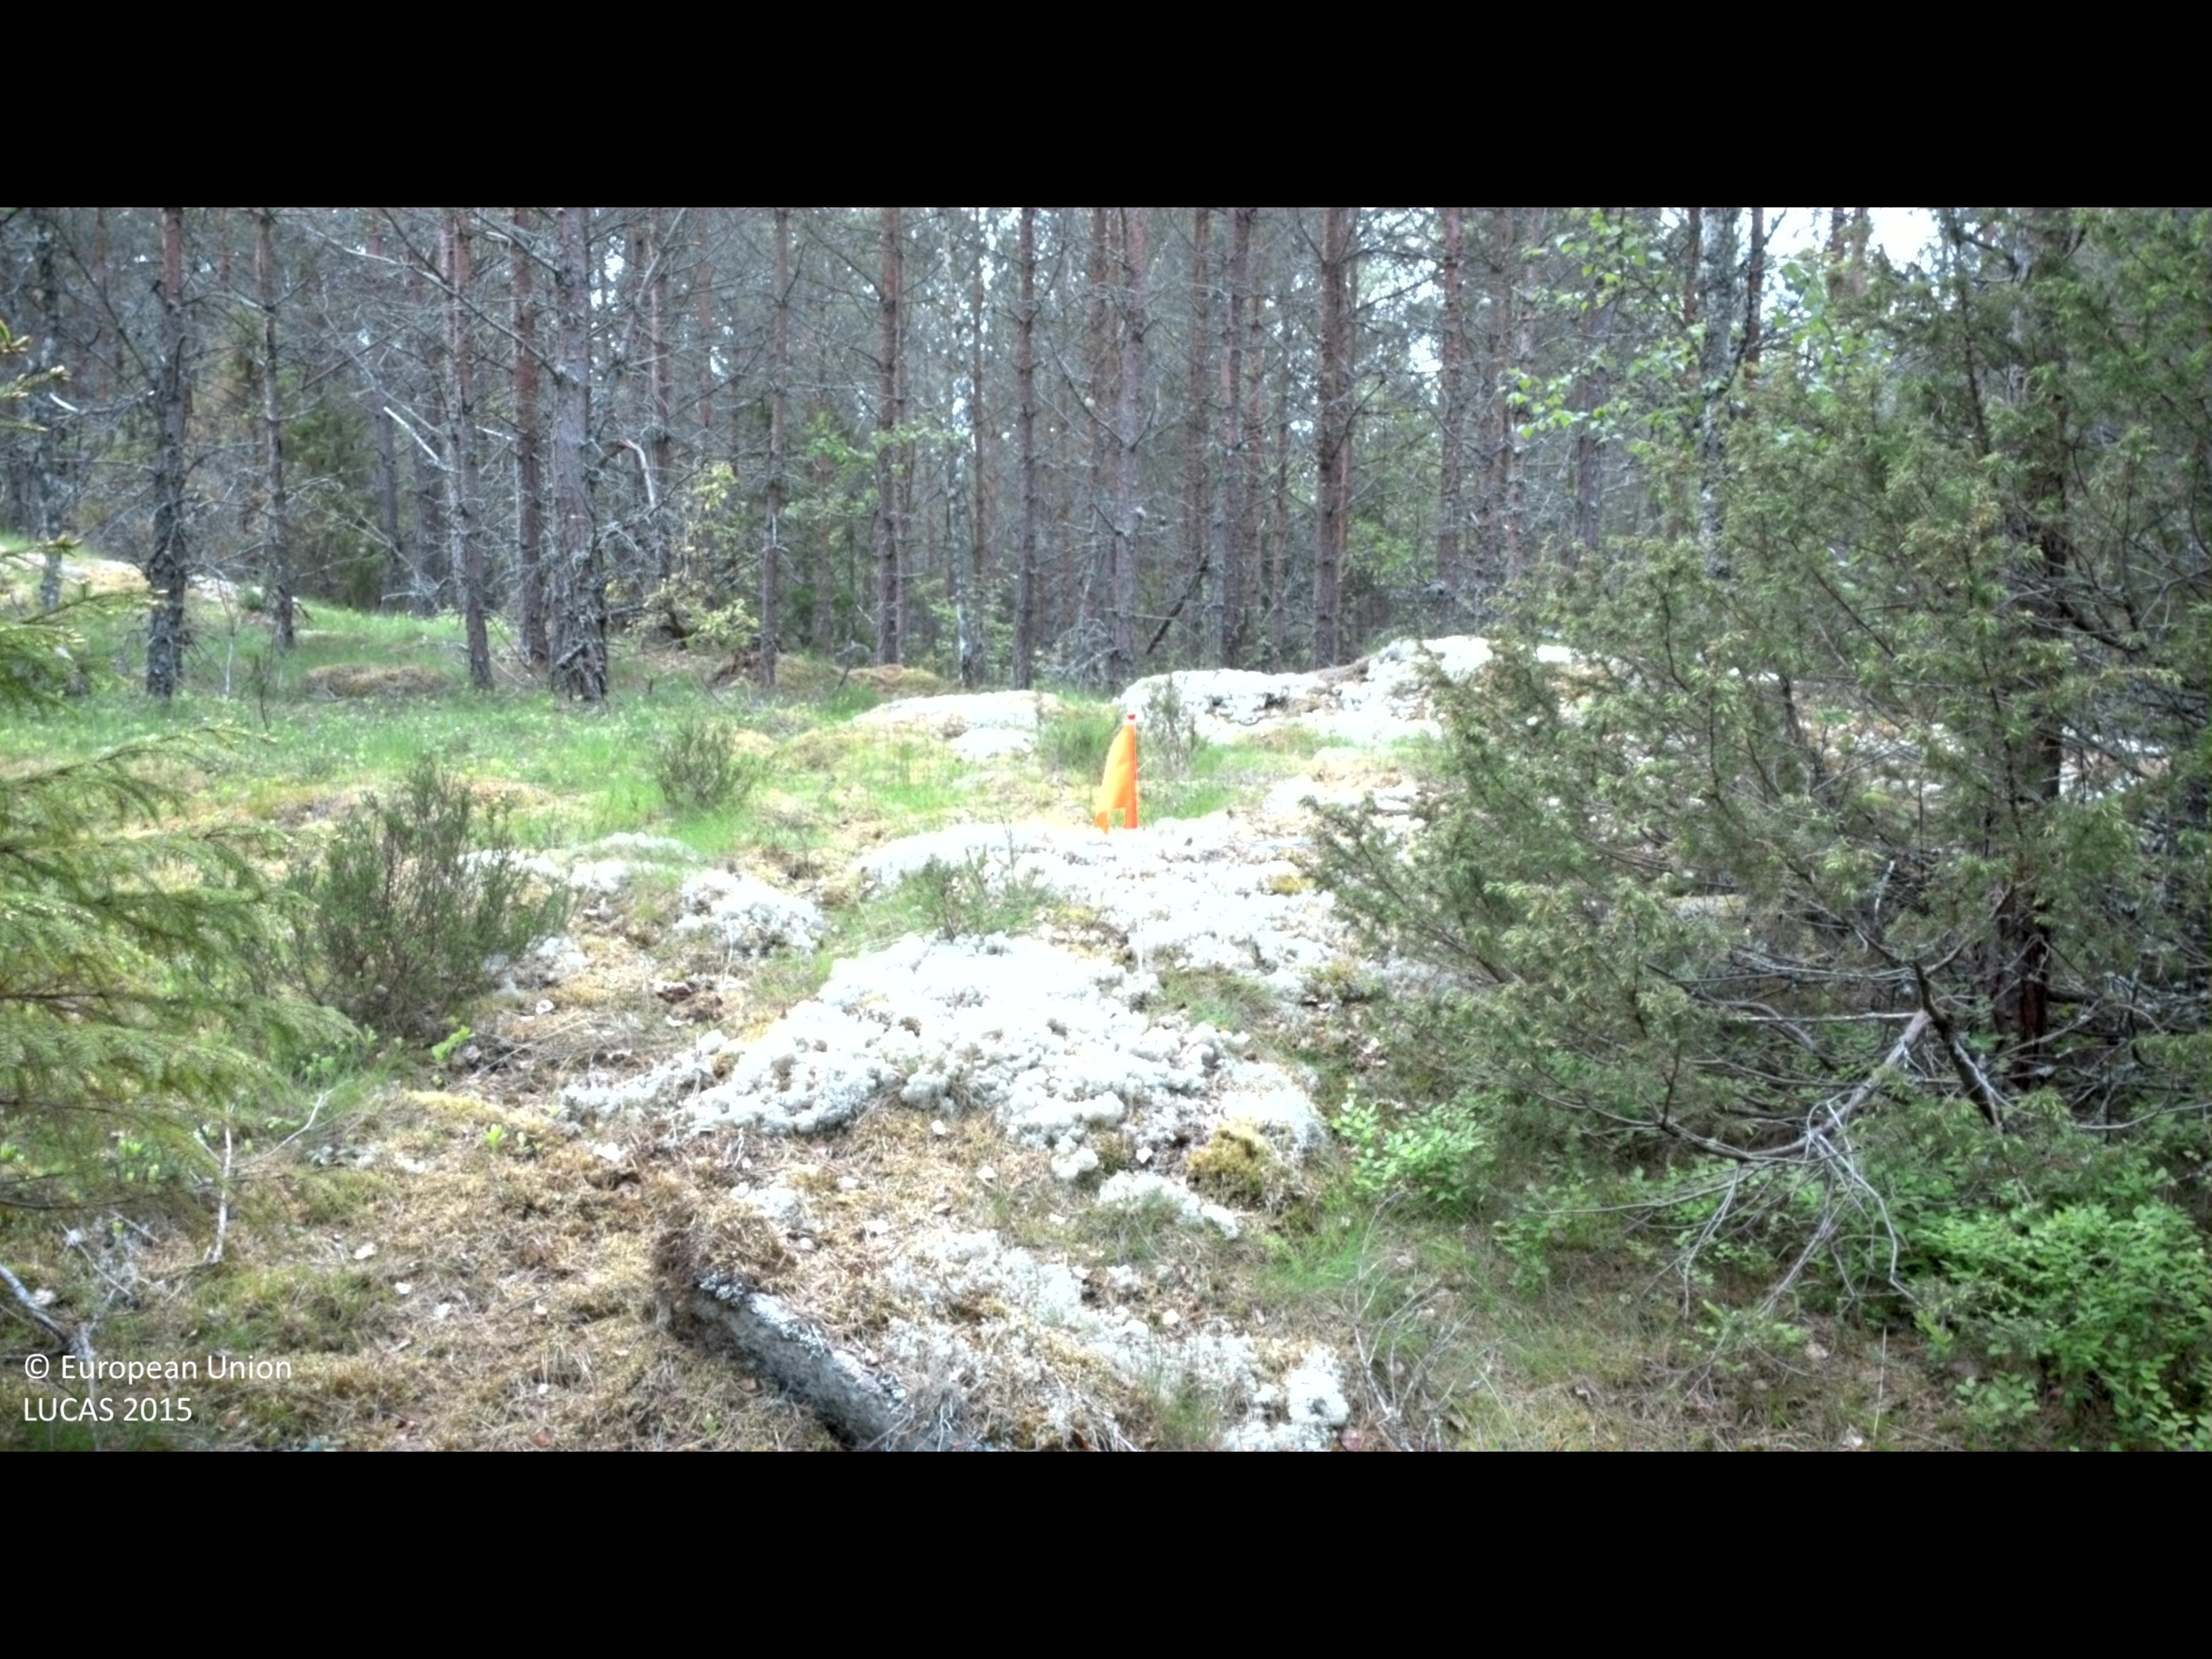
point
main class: Woodland
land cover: Pine dominated coniferous woodland
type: boreal forest
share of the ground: 25 - 50 %
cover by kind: coniferous forest trees 45 %, shrubs 30 %, lichens and mosses 20 %, broadleaved forest trees 5 %
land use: Forestry
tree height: > 5 m
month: June
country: SE
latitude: 57.6770
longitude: 16.2526
